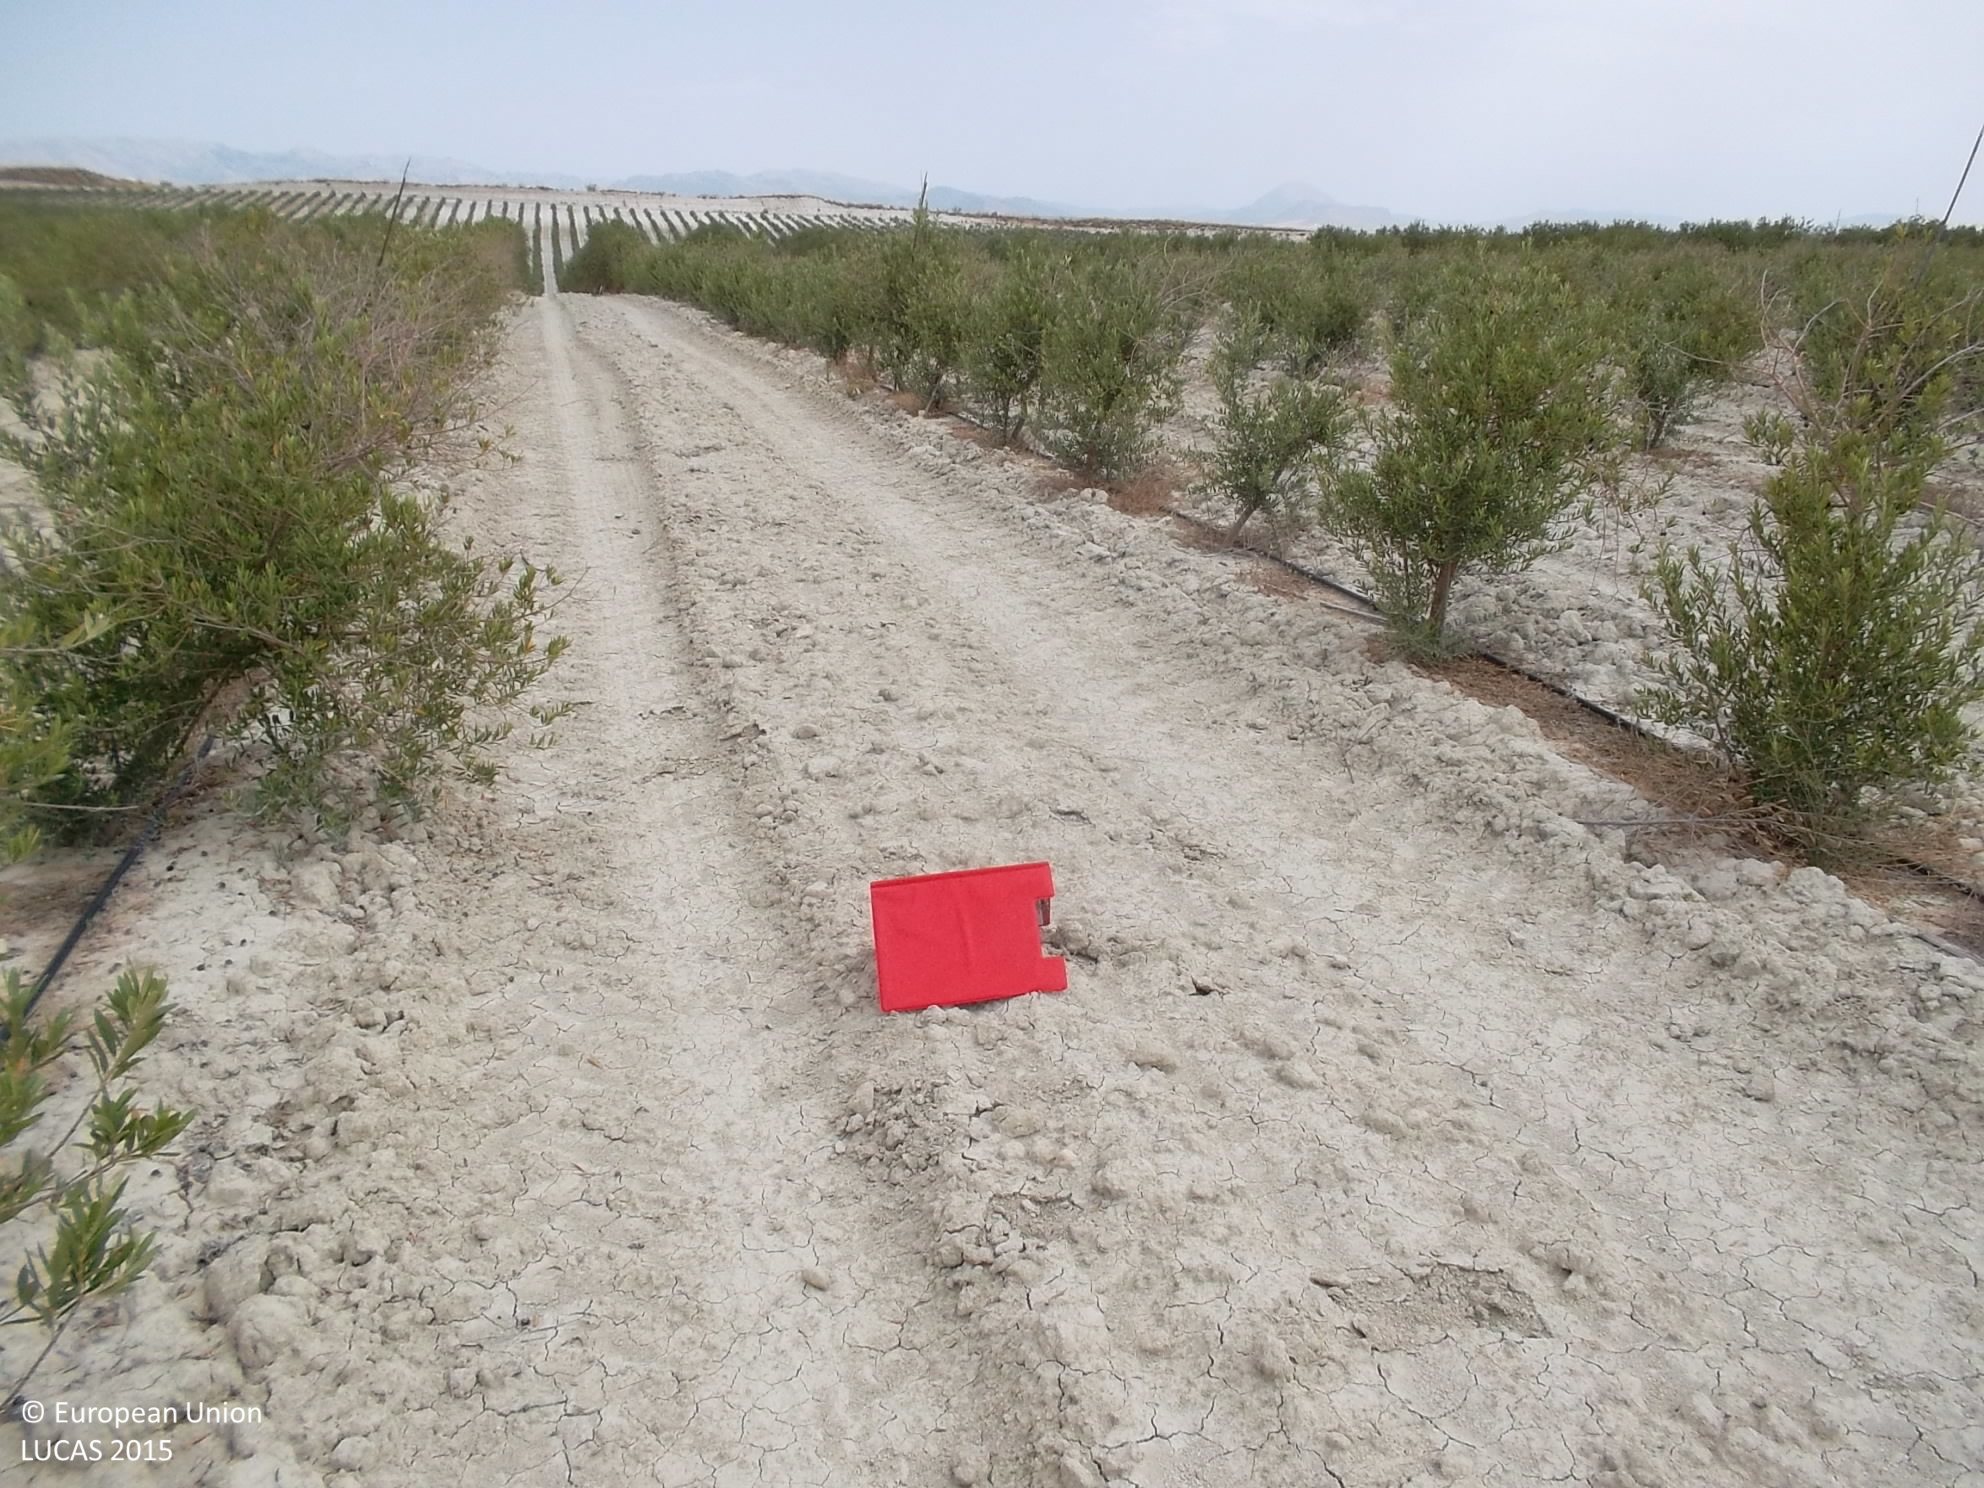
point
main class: Cropland
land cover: Olive groves
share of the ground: 25 - 50 %
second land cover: Other bare soil
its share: > 75 %
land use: Agriculture (excluding fallow land and kitchen gardens)
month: July
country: ES
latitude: 37.5792
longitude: -2.7726
